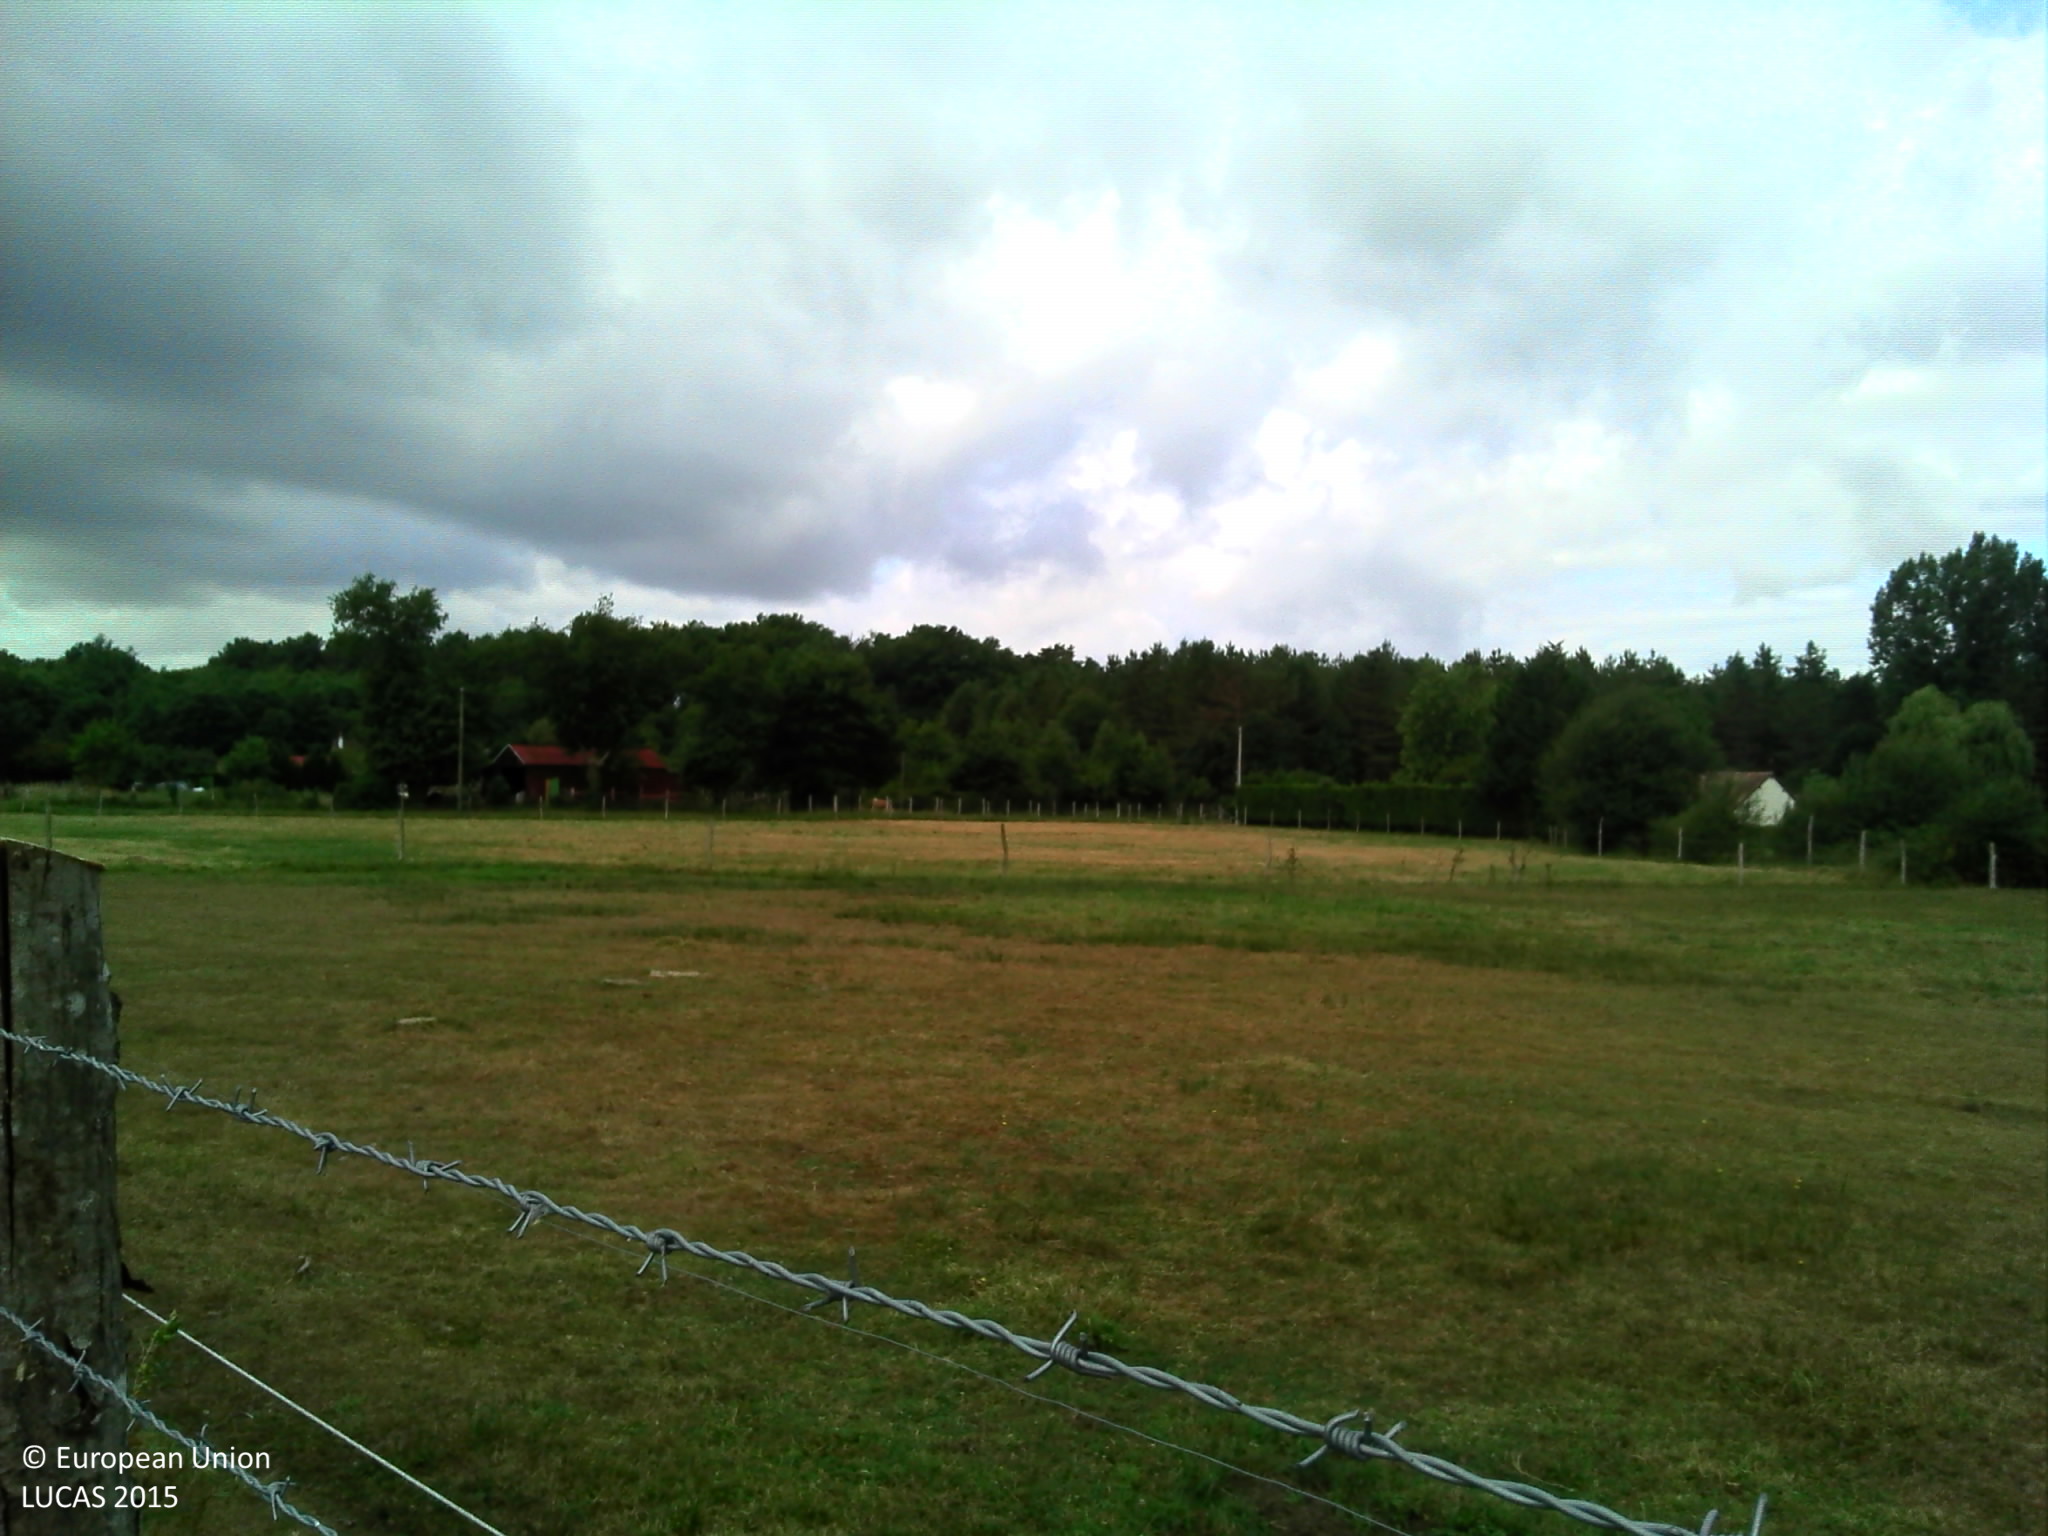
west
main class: Grassland
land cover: Grassland without tree/shrub cover
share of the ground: > 75 %
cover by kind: herbaceous plants 100 %
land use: Agriculture (excluding fallow land and kitchen gardens)
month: July
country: FR
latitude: 47.8077
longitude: 0.2406
